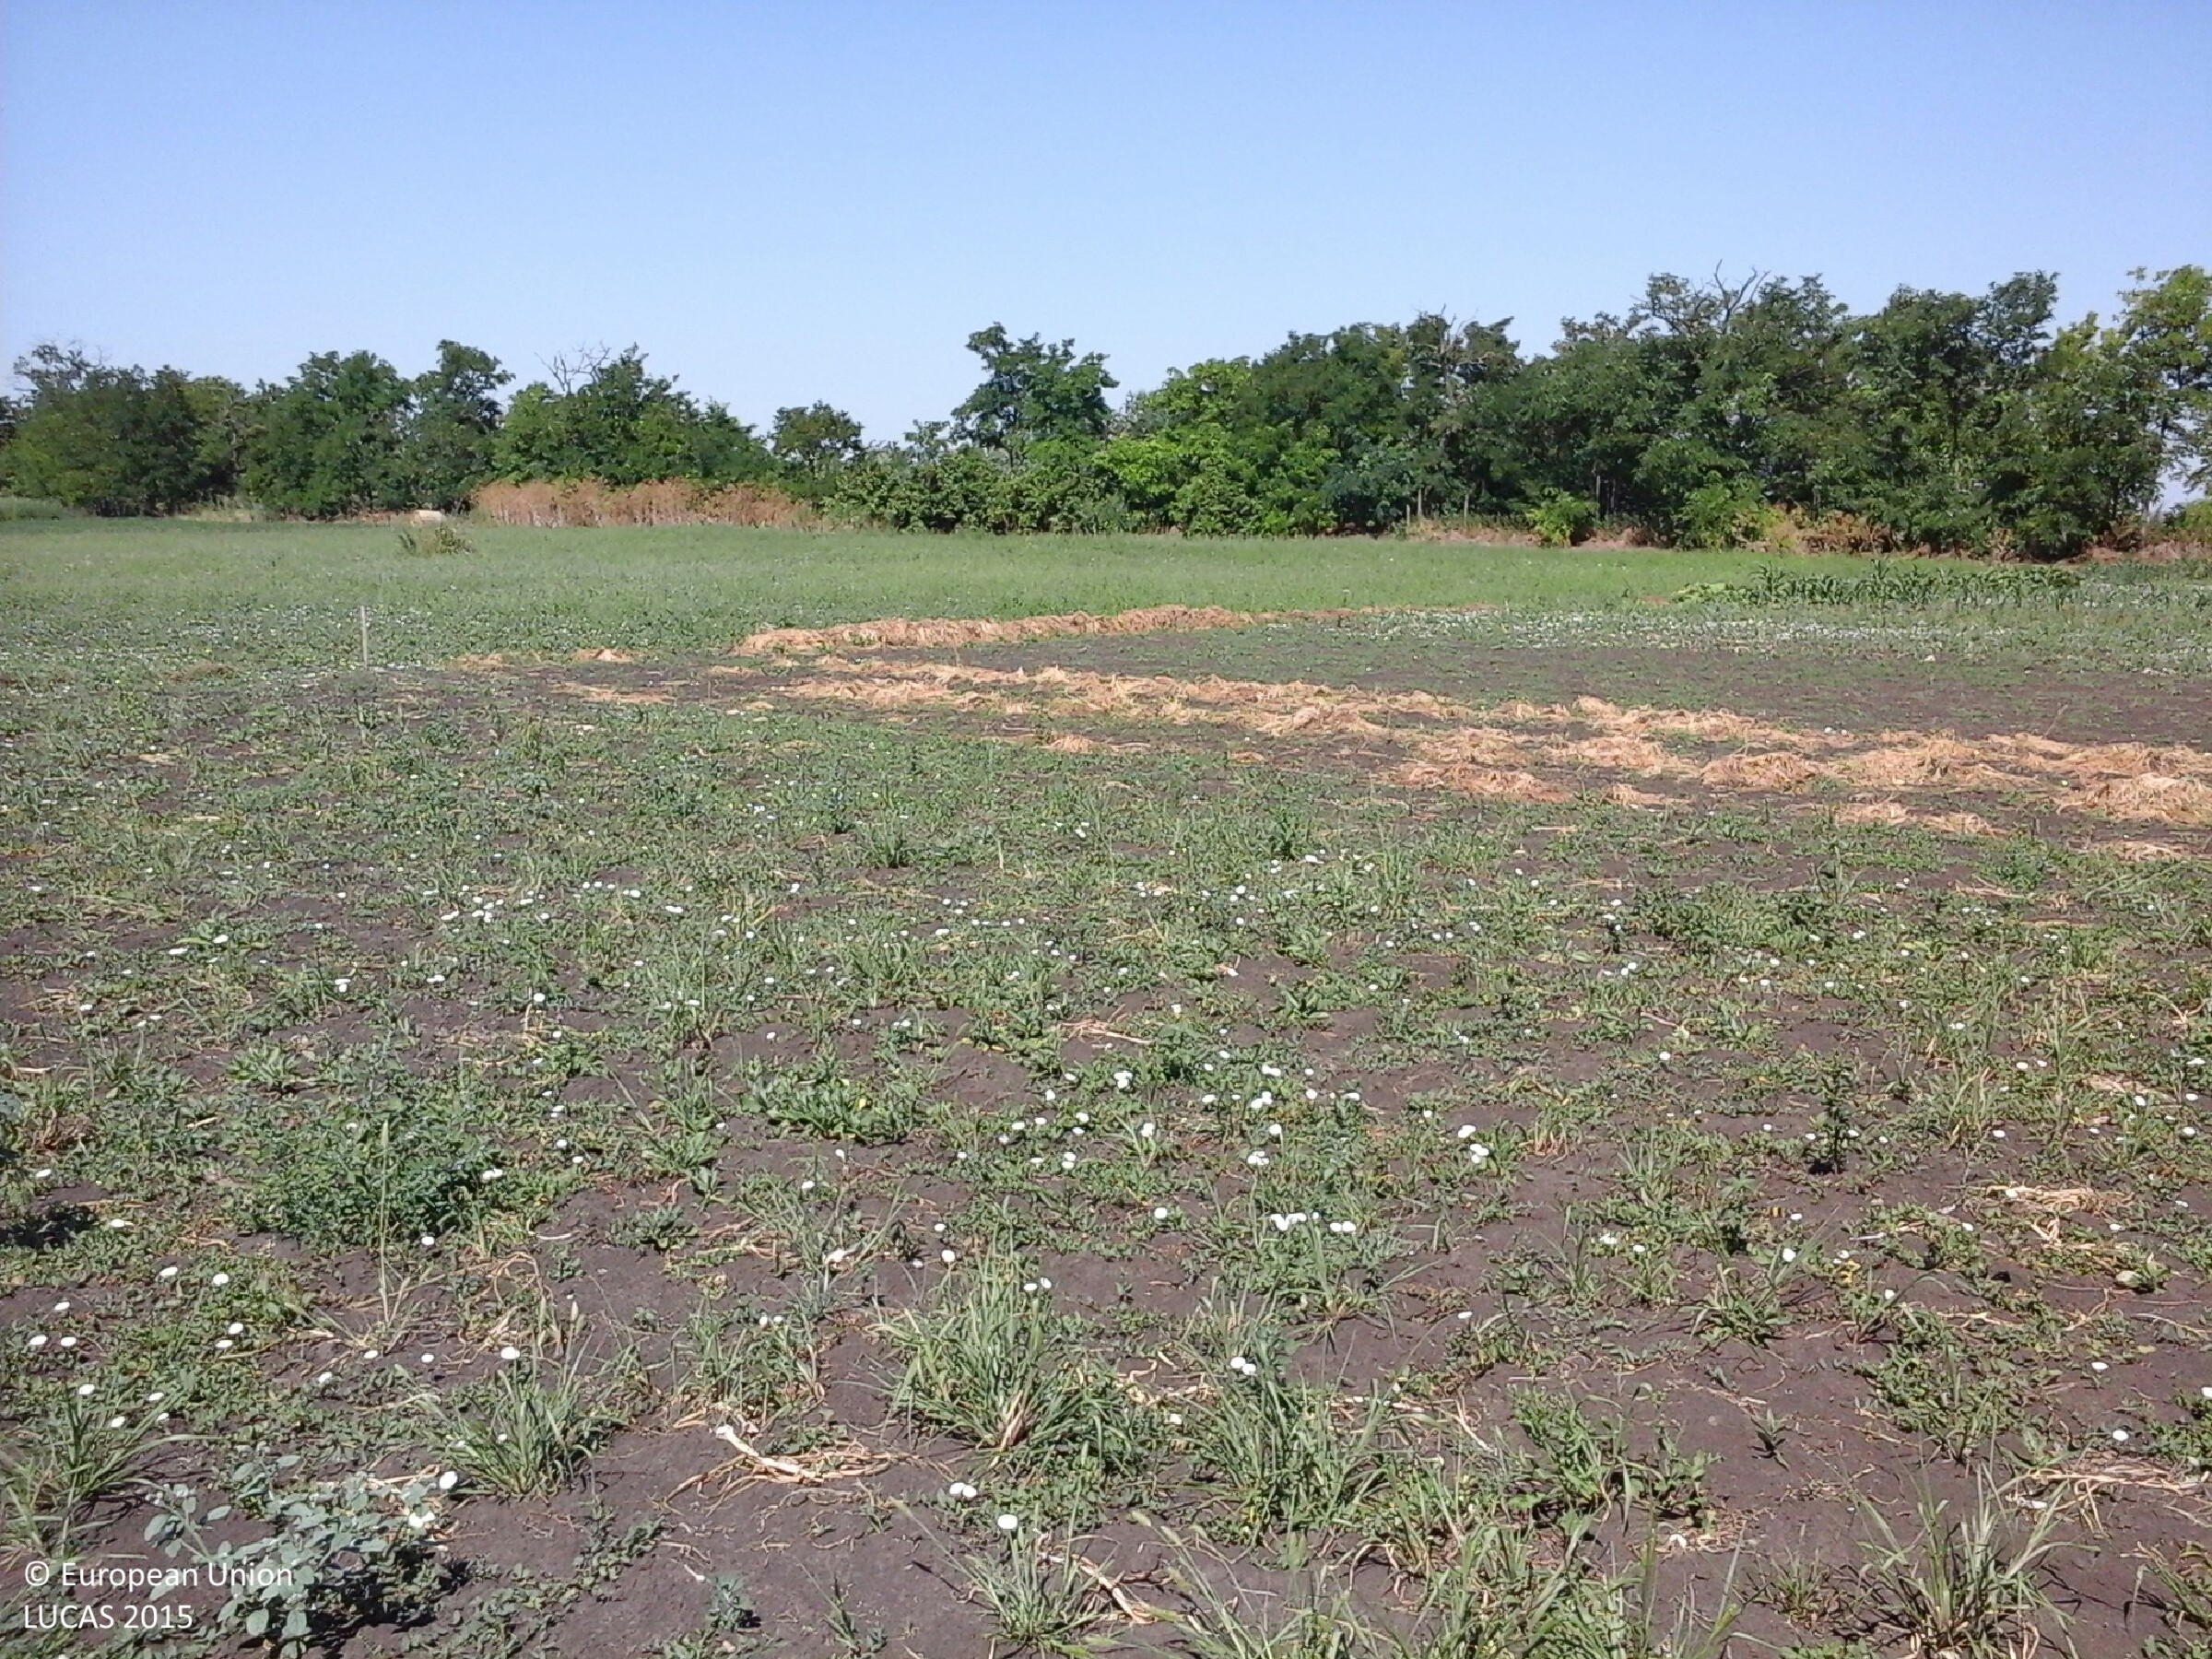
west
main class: Cropland
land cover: Other root crops
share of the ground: 25 - 50 %
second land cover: Spontaneously vegetated surfaces
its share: 25 - 50 %
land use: Agriculture (excluding fallow land and kitchen gardens)
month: July
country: HU
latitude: 47.6218
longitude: 20.5841
